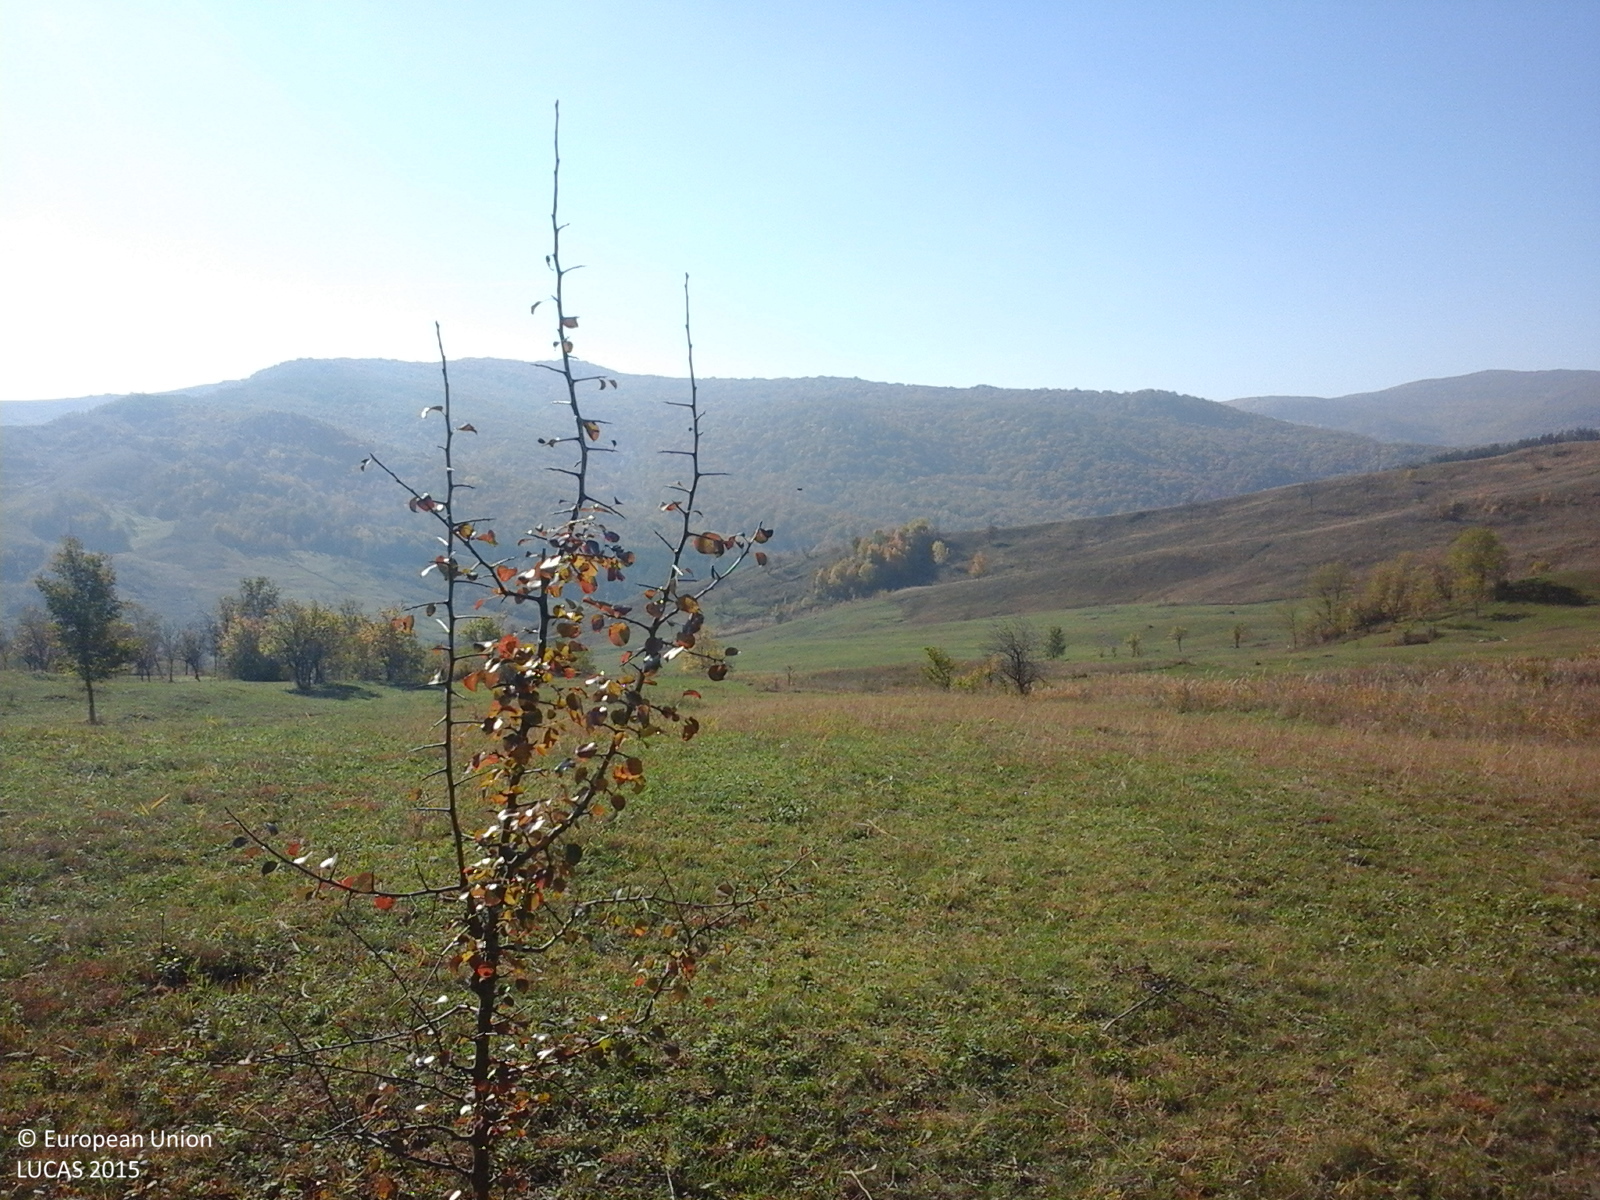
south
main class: Grassland
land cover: Grassland with sparse tree/shrub cover
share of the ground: > 75 %
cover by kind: herbaceous plants 85 %, shrubs 10 %, broadleaved forest trees 5 %
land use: Agriculture (excluding fallow land and kitchen gardens)
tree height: < 5 m
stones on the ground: < 10 %
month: October
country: RO
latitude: 45.3133
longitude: 26.5150
